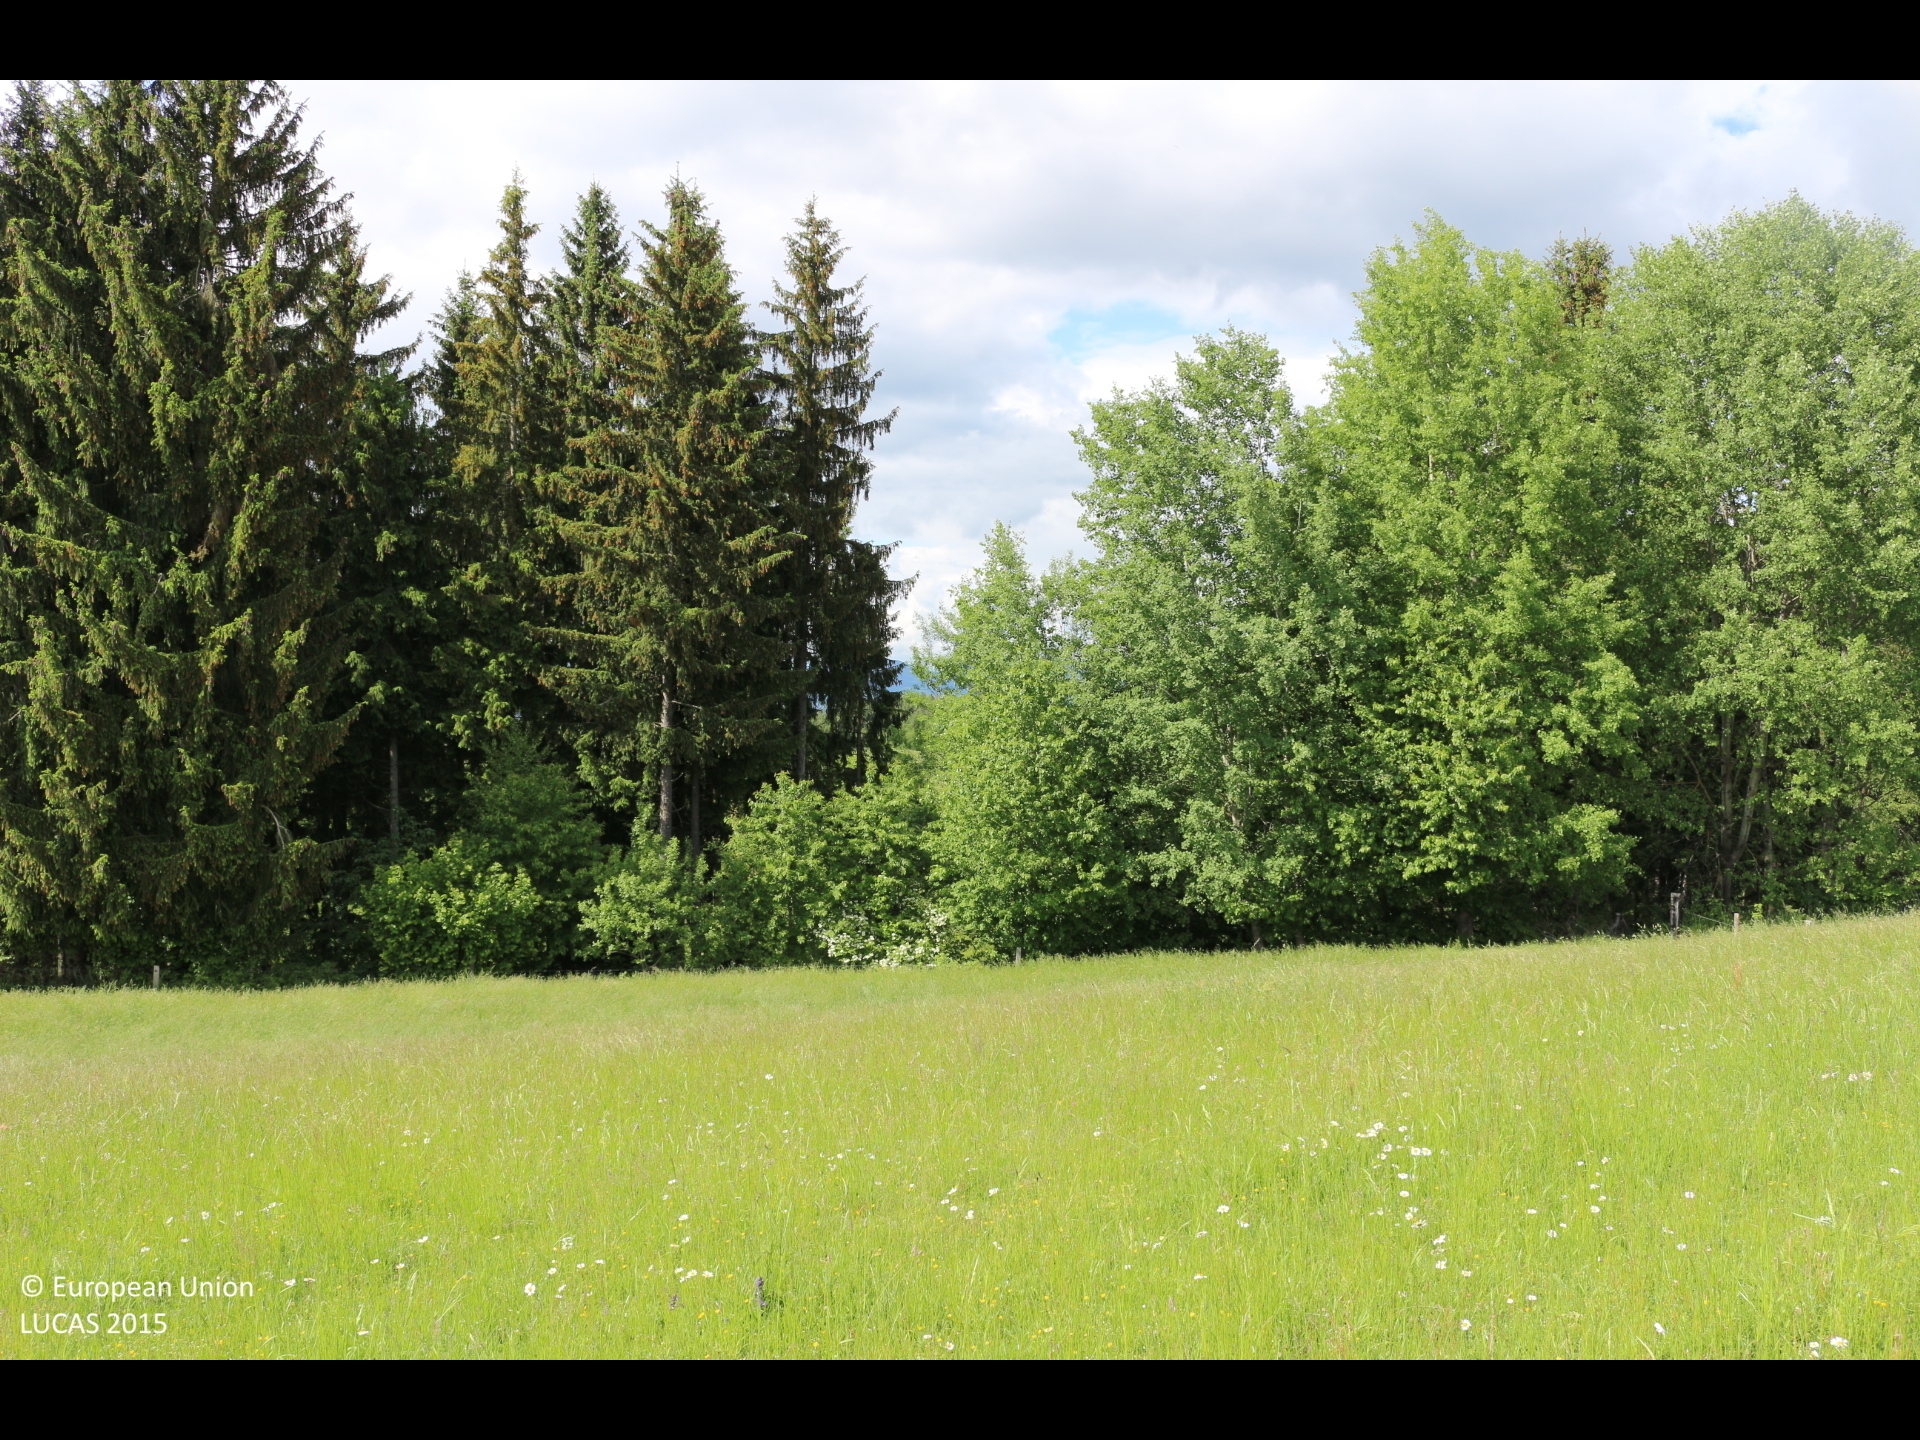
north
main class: Grassland
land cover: Grassland without tree/shrub cover
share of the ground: > 75 %
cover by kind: herbaceous plants 100 %
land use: Agriculture (excluding fallow land and kitchen gardens)
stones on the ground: < 10 %
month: May
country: AT
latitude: 46.5845
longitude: 14.4216
